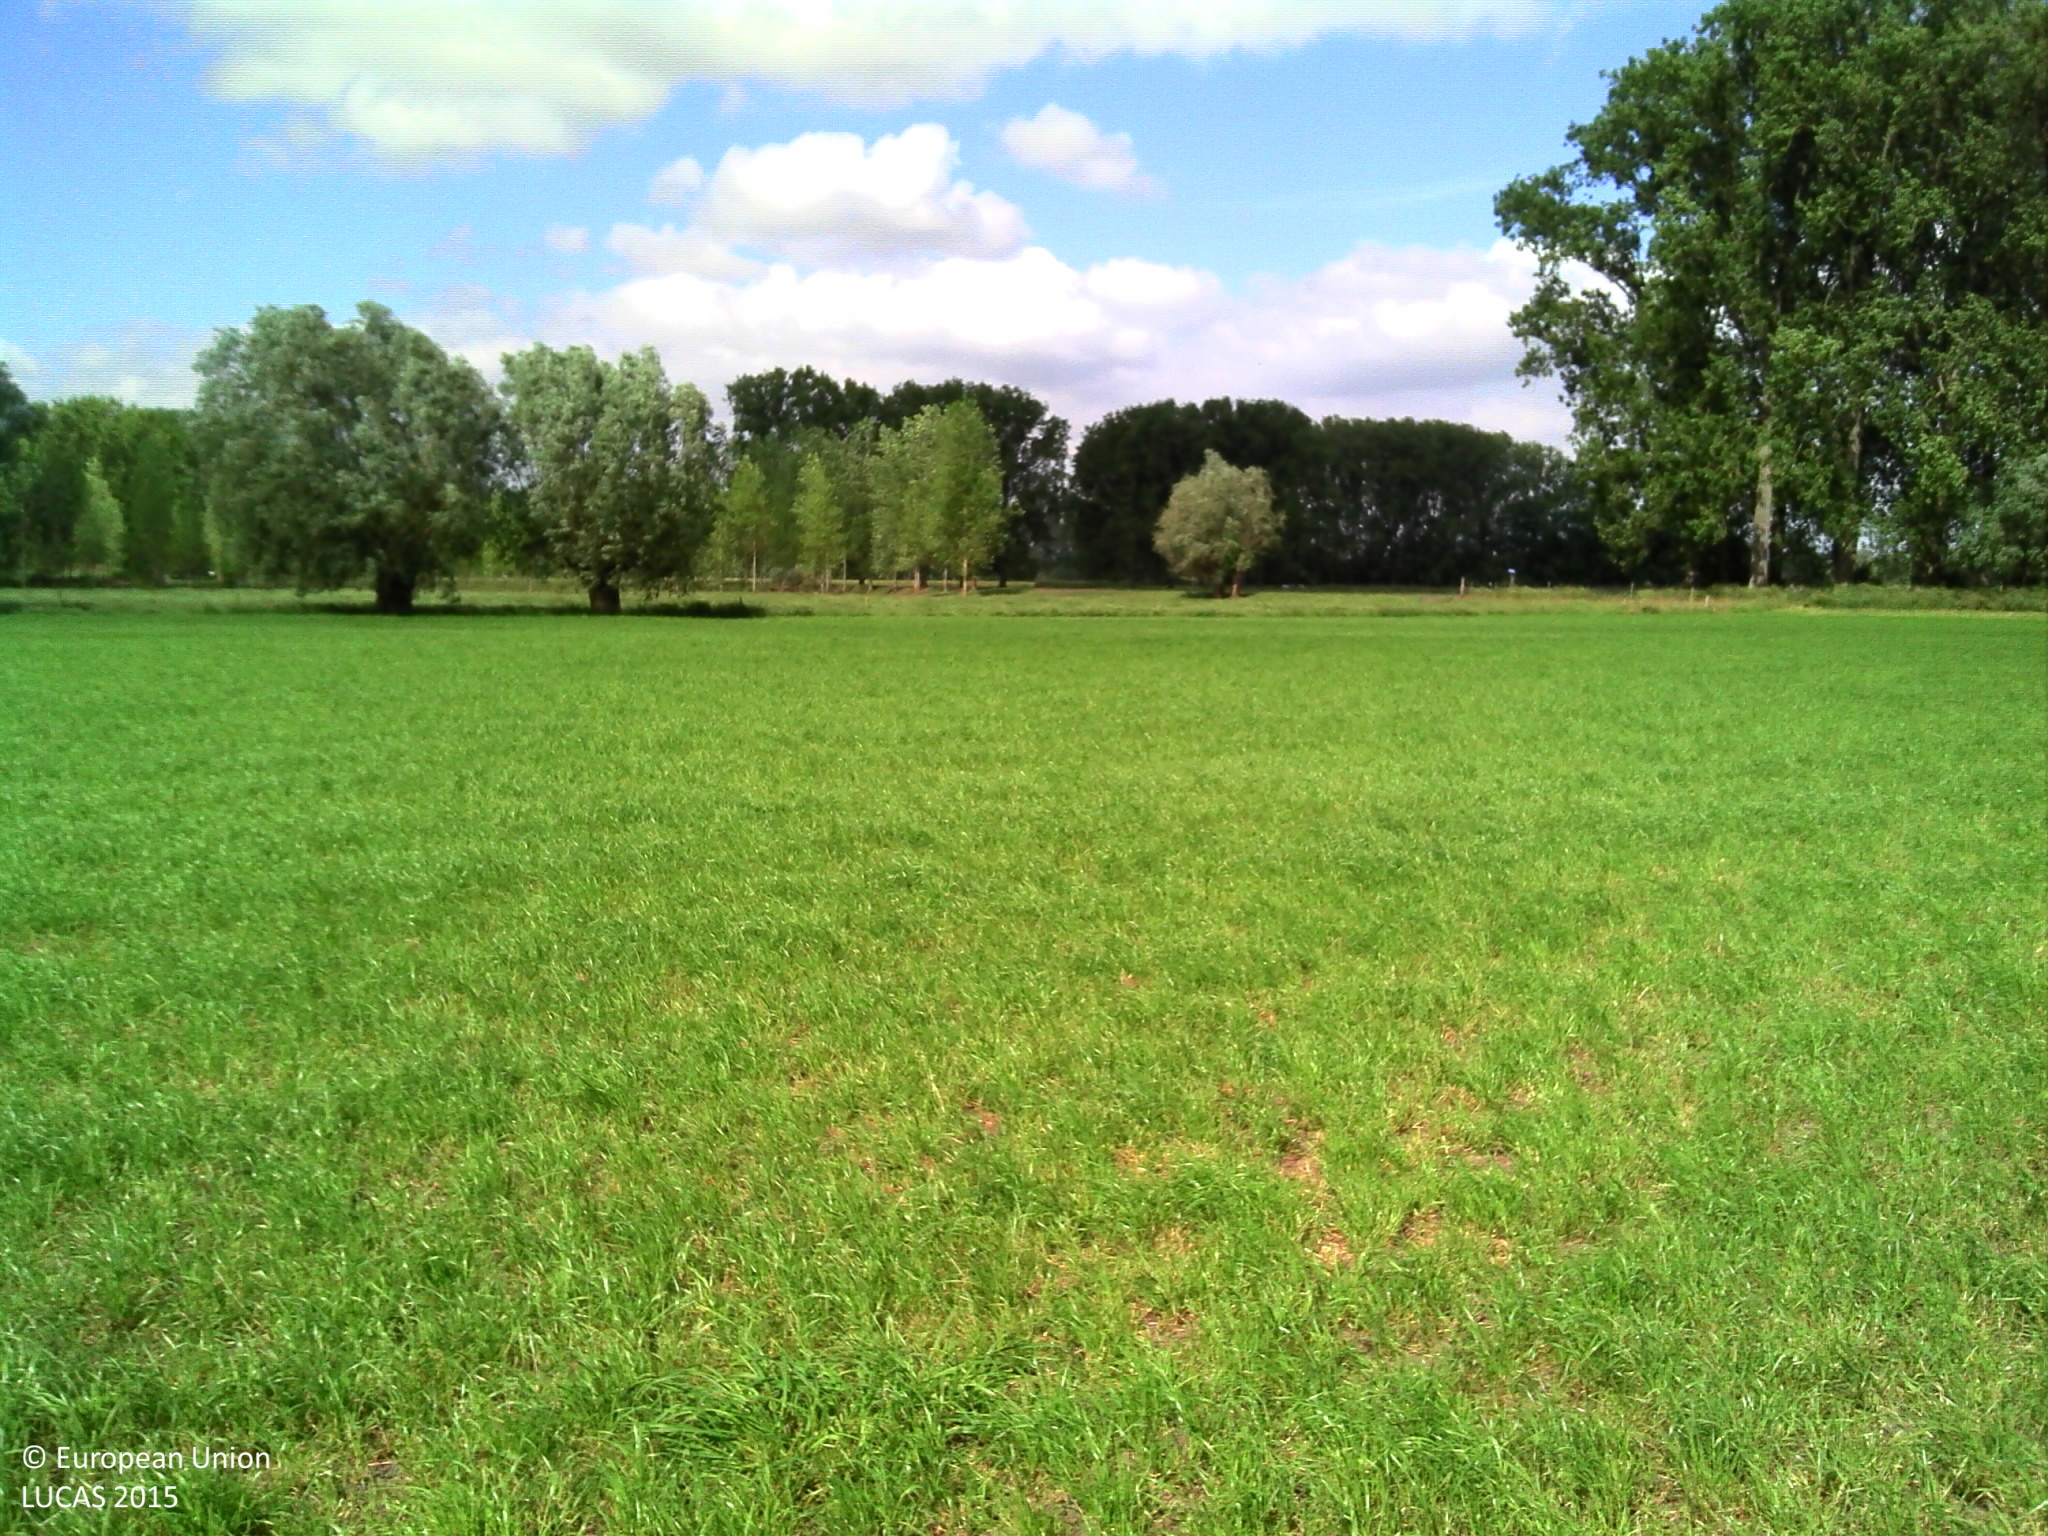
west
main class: Cropland
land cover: Temporary grasslands
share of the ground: > 75 %
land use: Agriculture (excluding fallow land and kitchen gardens)
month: June
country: BE
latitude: 50.9651
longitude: 3.6851
